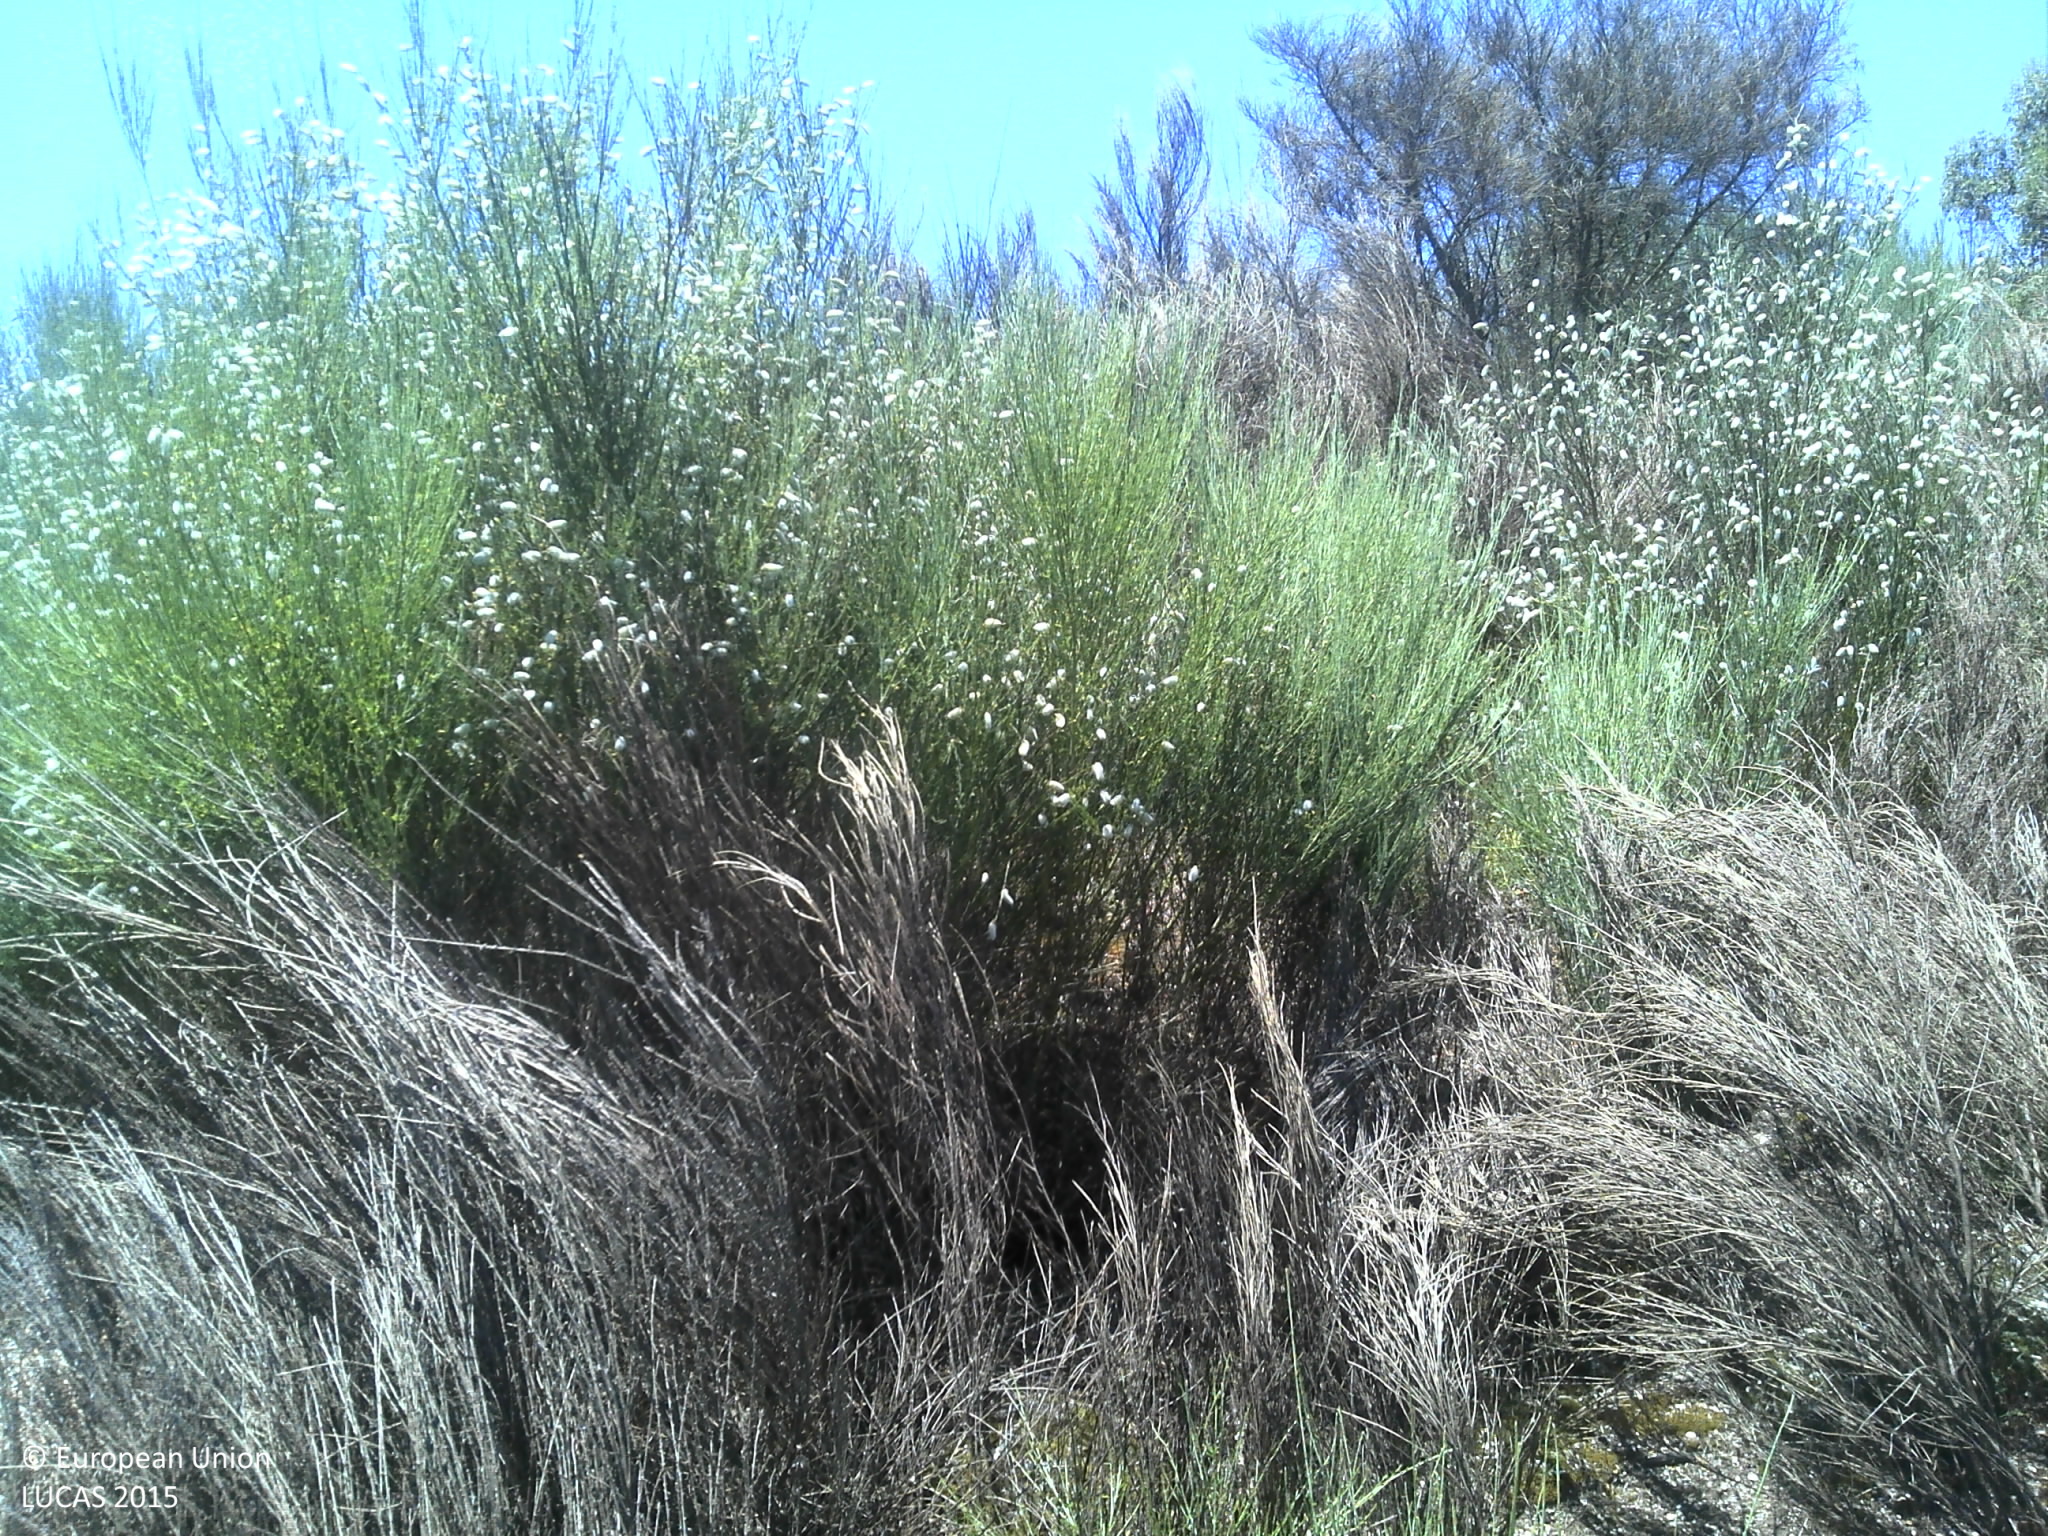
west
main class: Shrubland
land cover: Shrubland without tree cover
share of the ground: > 75 %
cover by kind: shrubs 80 %, herbaceous plants 15 %, unconsolidated bare surface 5 %
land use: Semi-natural and natural areas not in use
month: June
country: PT
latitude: 41.4220
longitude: -8.0528
